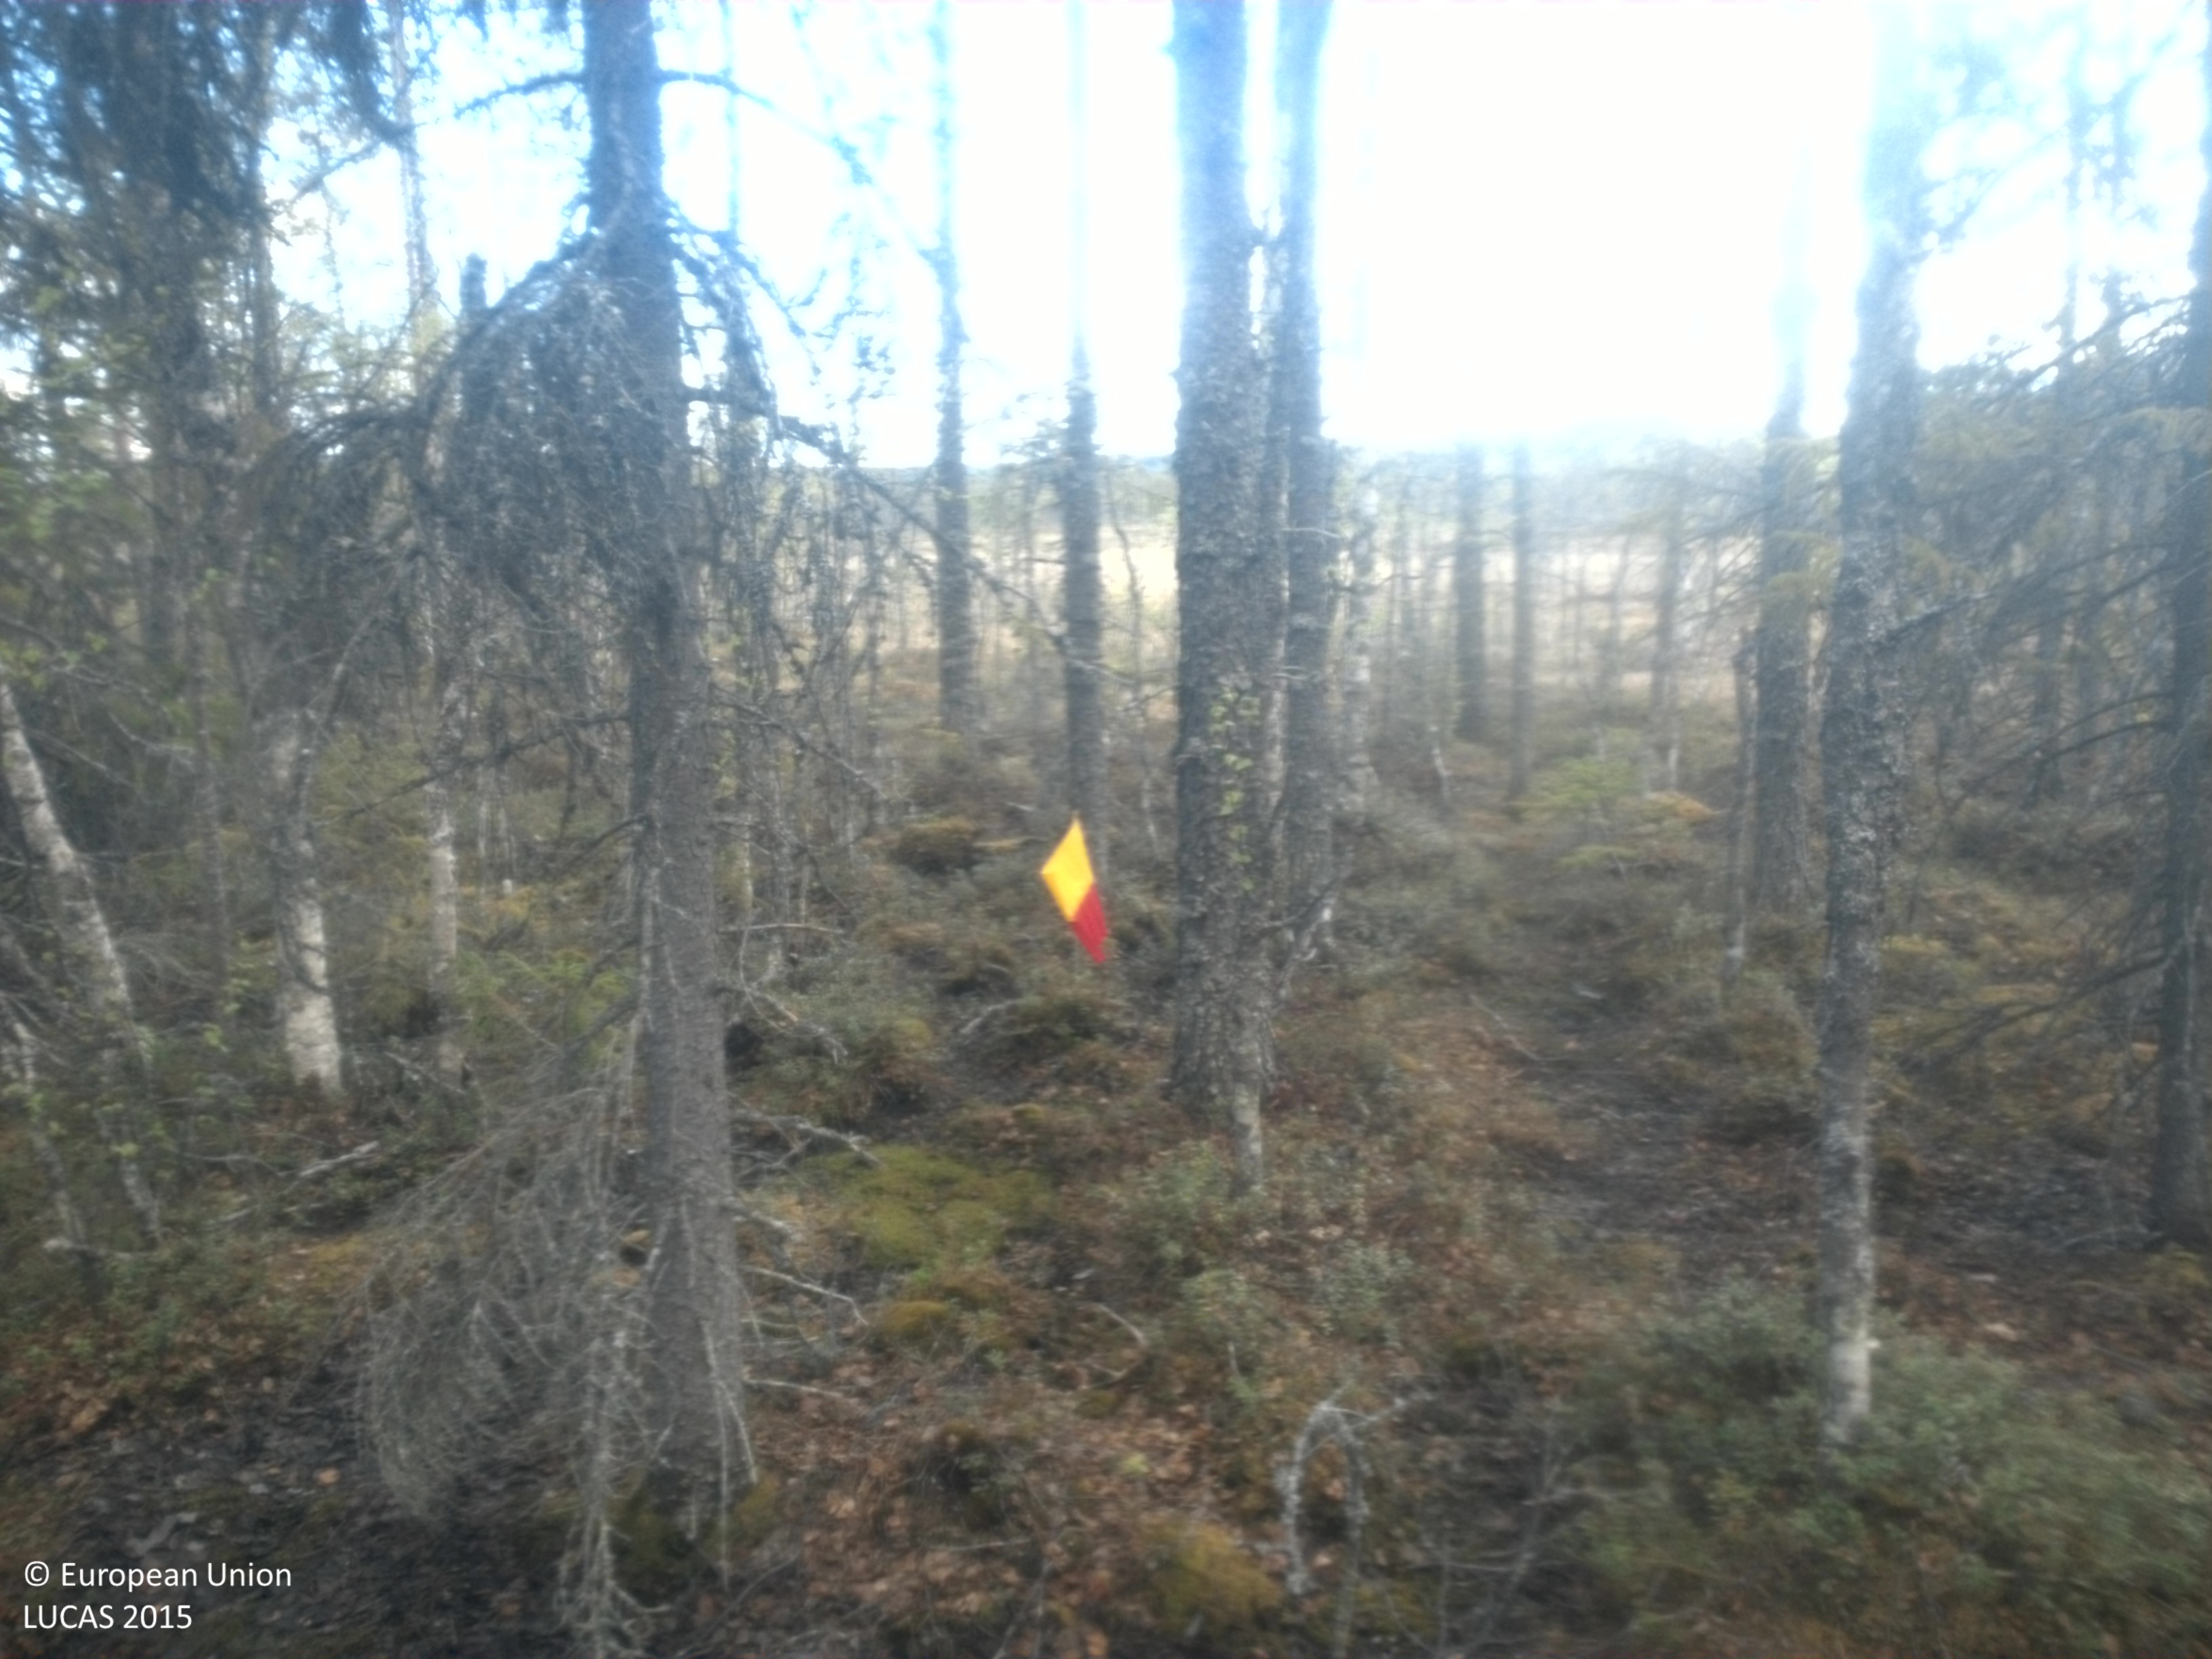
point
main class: Woodland
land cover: Pine dominated coniferous woodland
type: boreal forest
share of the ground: 50 - 75 %
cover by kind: coniferous forest trees 55 %, broadleaved forest trees 10 %, shrubs 10 %, herbaceous plants 10 %, lichens and mosses 10 %, unconsolidated bare surface 5 %
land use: Forestry
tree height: > 5 m
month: June
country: SE
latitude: 64.3945
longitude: 17.6620
